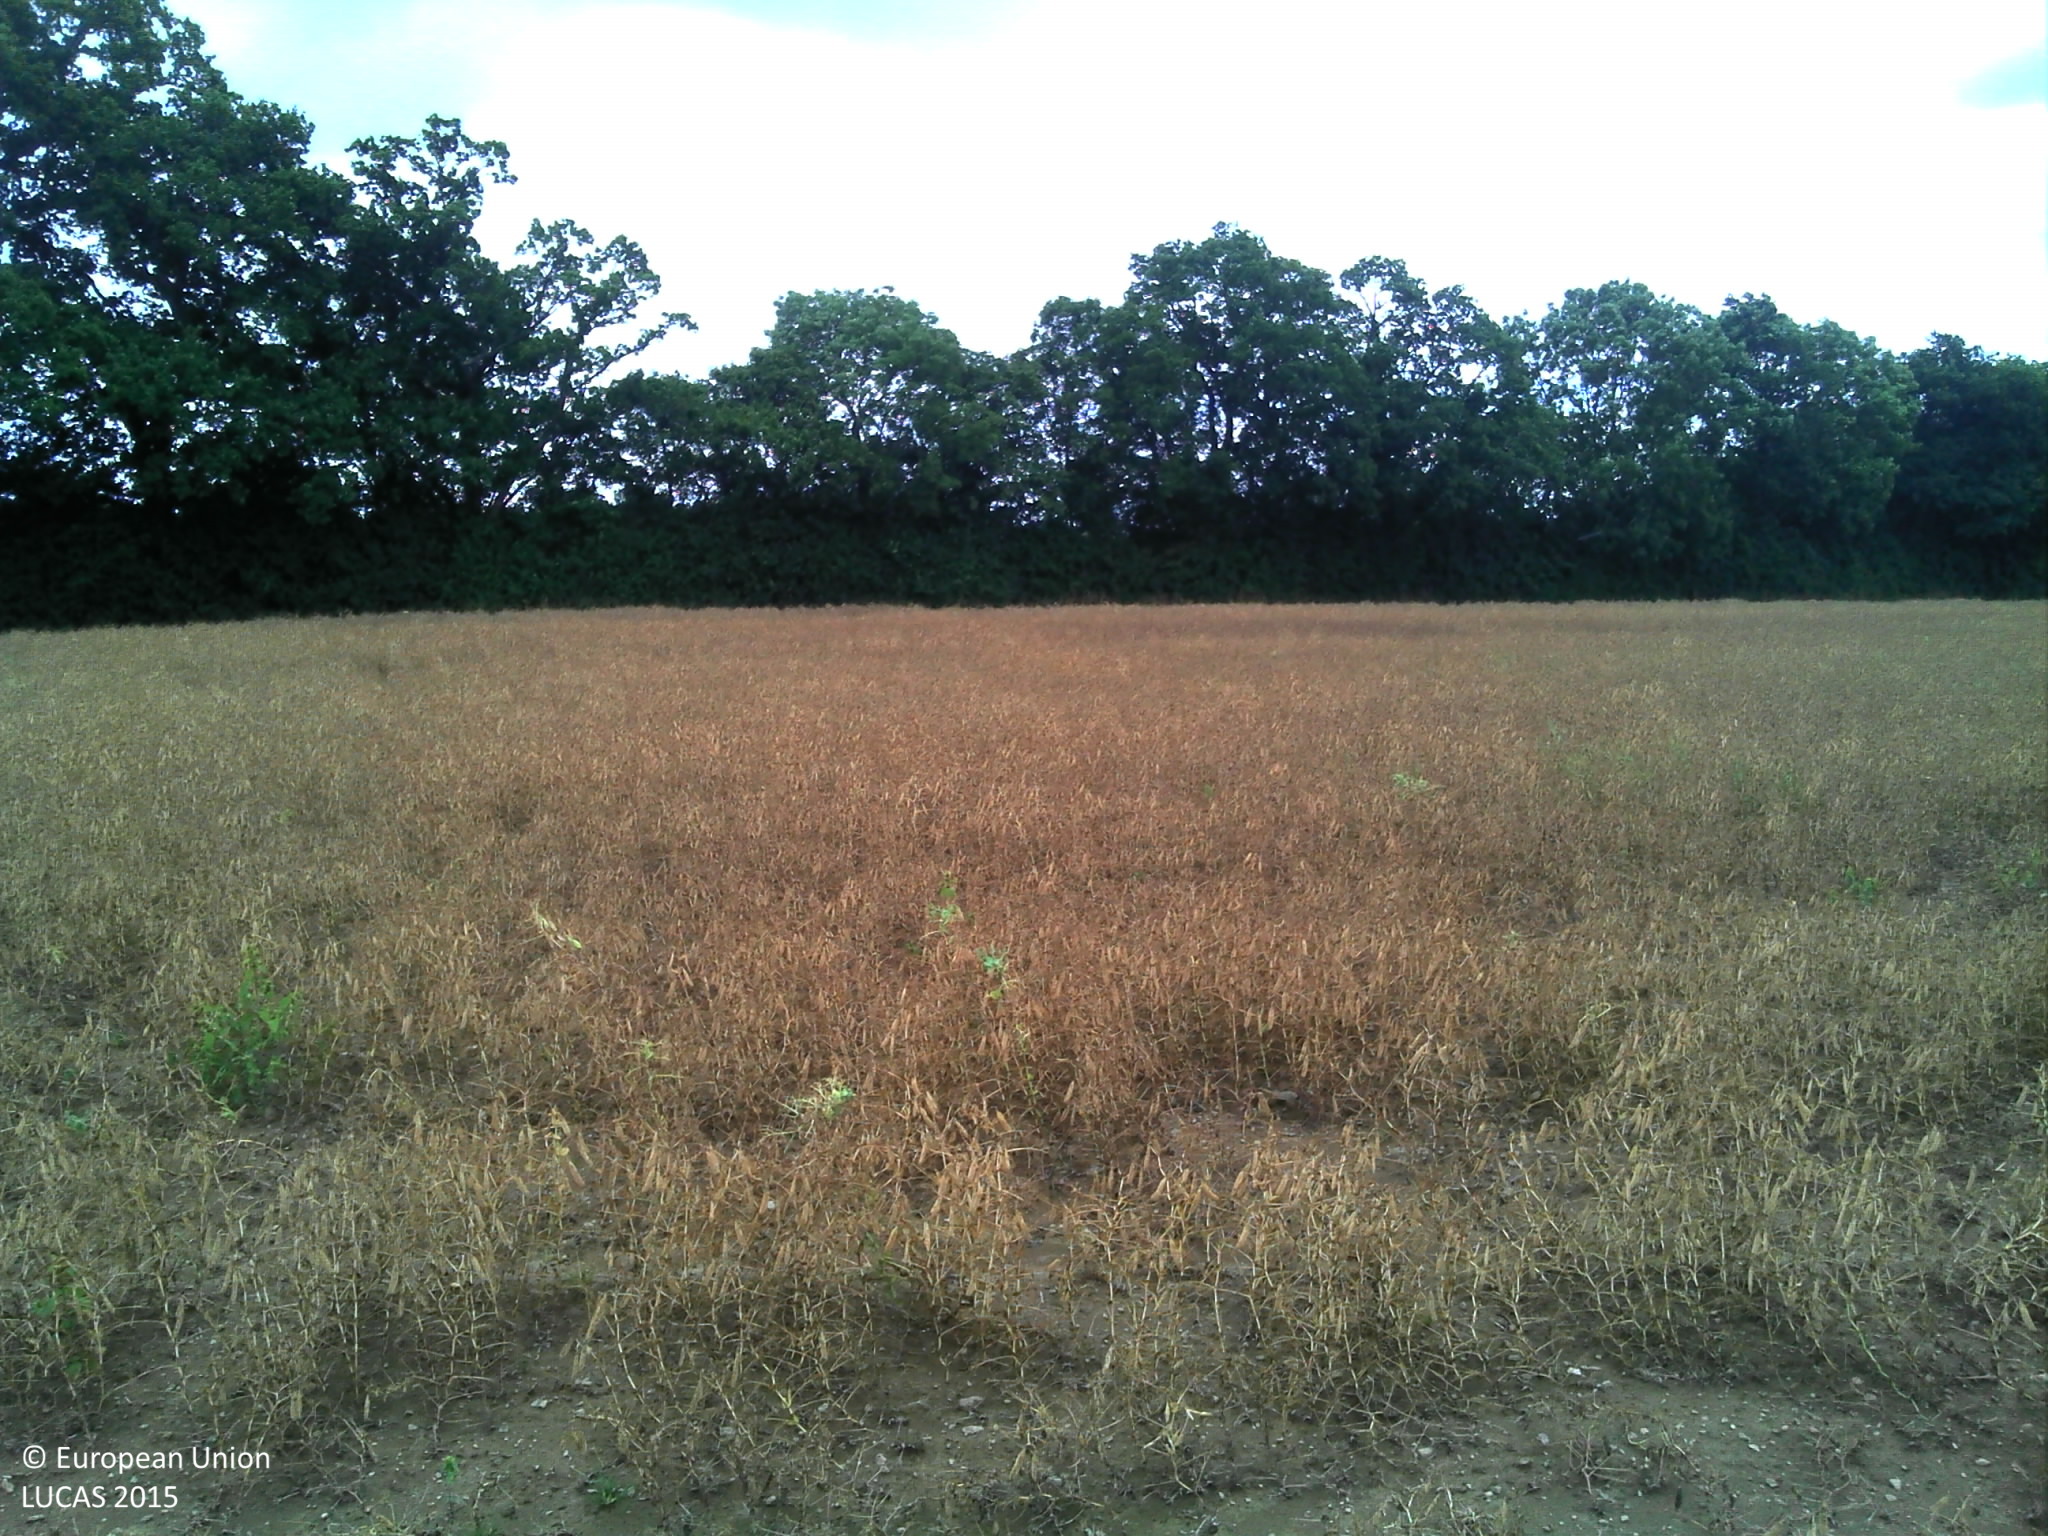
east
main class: Cropland
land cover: Dry pulses
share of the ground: > 75 %
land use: Agriculture (excluding fallow land and kitchen gardens)
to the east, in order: Dry pulses; Grass margins; Managed hedges; Broadleaved woodland; Grassland without tree/shrub cover; Managed hedges; Fences; Broadleaved woodland; Common wheat
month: July
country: FR
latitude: 48.8314
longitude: -0.2638
